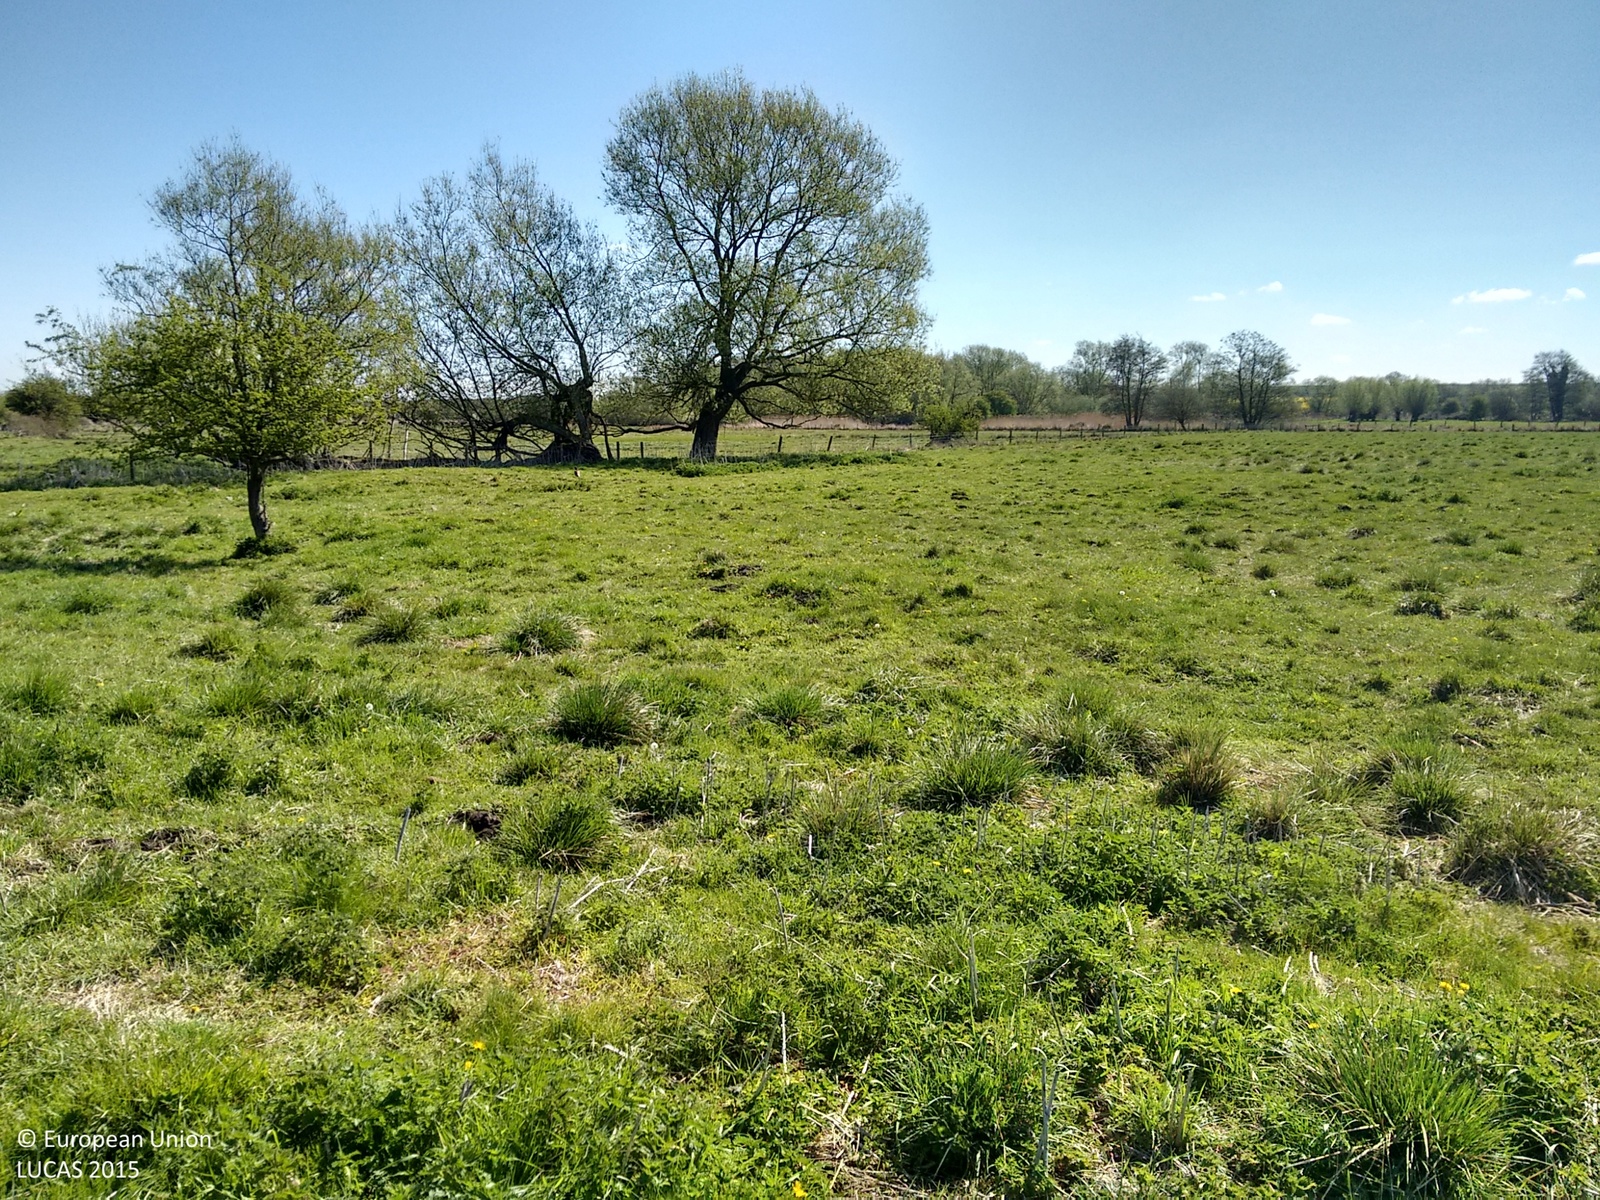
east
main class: Grassland
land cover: Grassland without tree/shrub cover
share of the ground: > 75 %
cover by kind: herbaceous plants 100 %
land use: Agriculture (excluding fallow land and kitchen gardens)
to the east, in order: Grassland without tree/shrub cover; Fences; Abandoned hedges; Grassland without tree/shrub cover
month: April
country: GB
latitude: 51.1704
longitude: -1.4203
